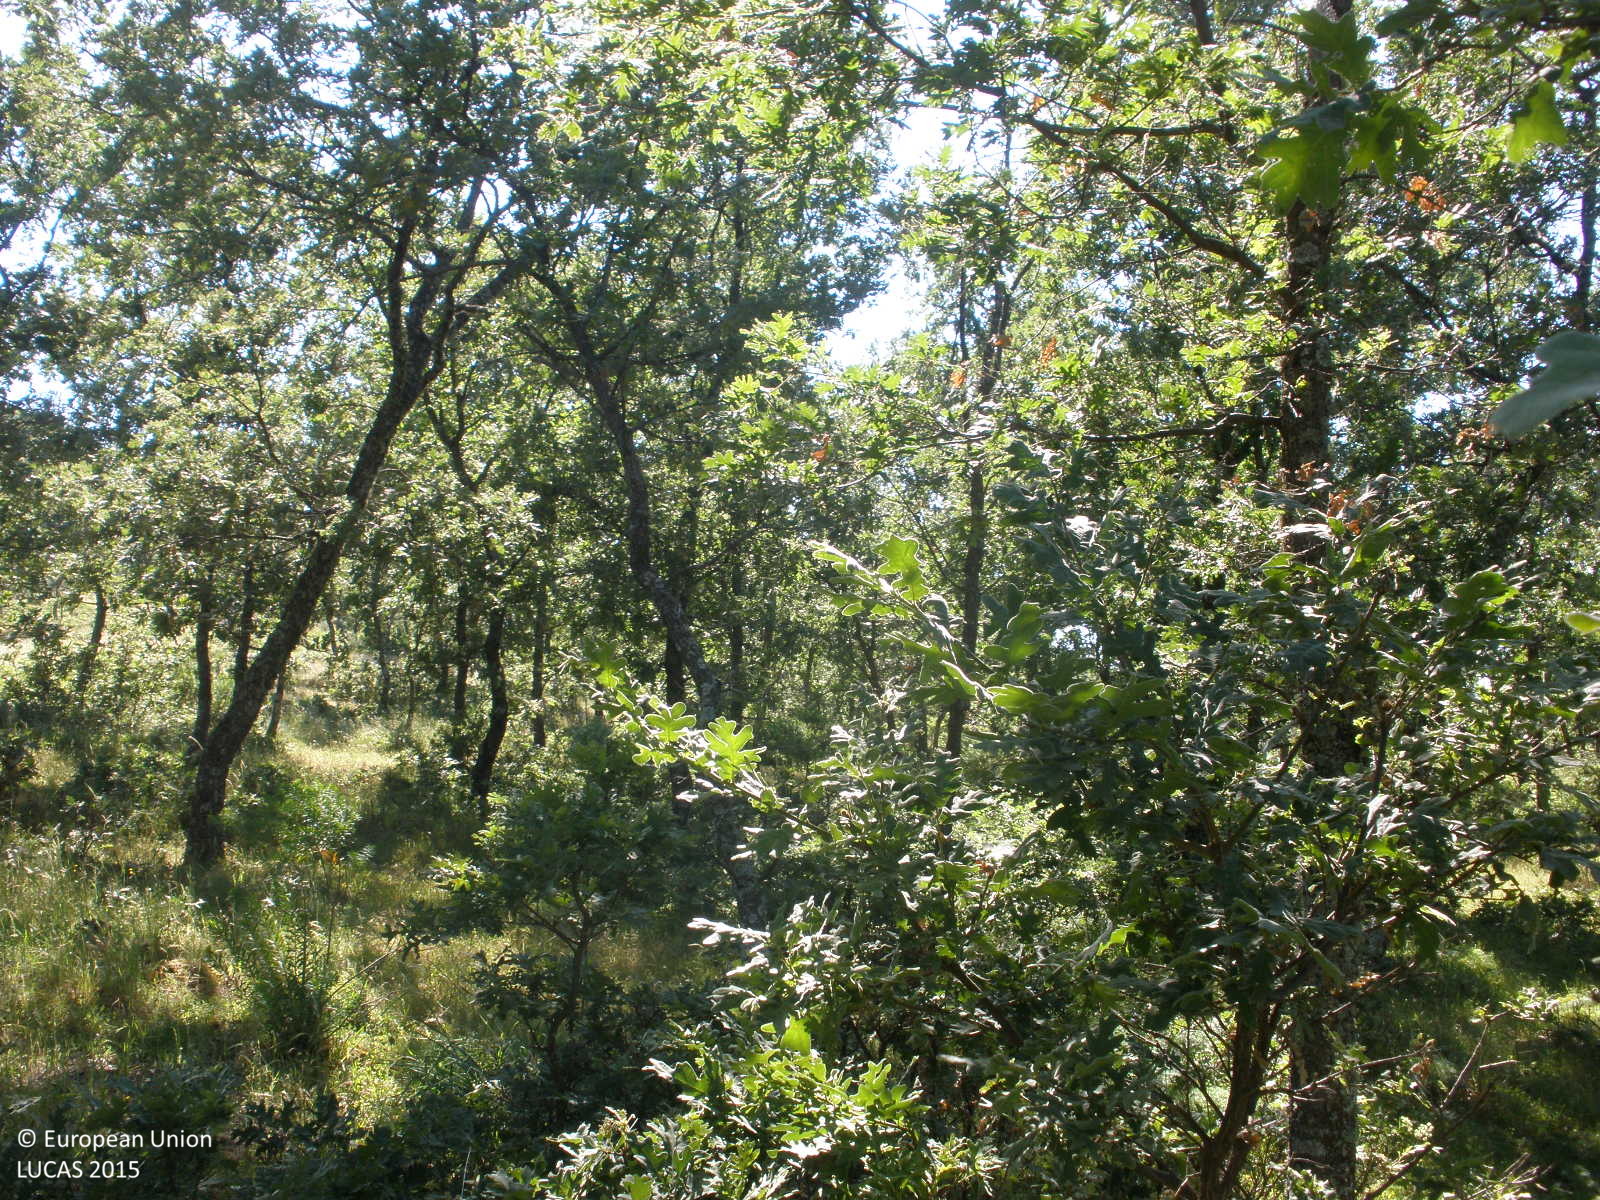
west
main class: Woodland
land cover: Broadleaved woodland
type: broadleaved evergreen forest
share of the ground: > 75 %
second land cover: Grassland without tree/shrub cover
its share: > 75 %
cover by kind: broadleaved forest trees 80 %, herbaceous plants 20 %
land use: Forestry
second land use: Agriculture (excluding fallow land and kitchen gardens)
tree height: > 5 m
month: May
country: ES
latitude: 40.1358
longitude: -6.7891
